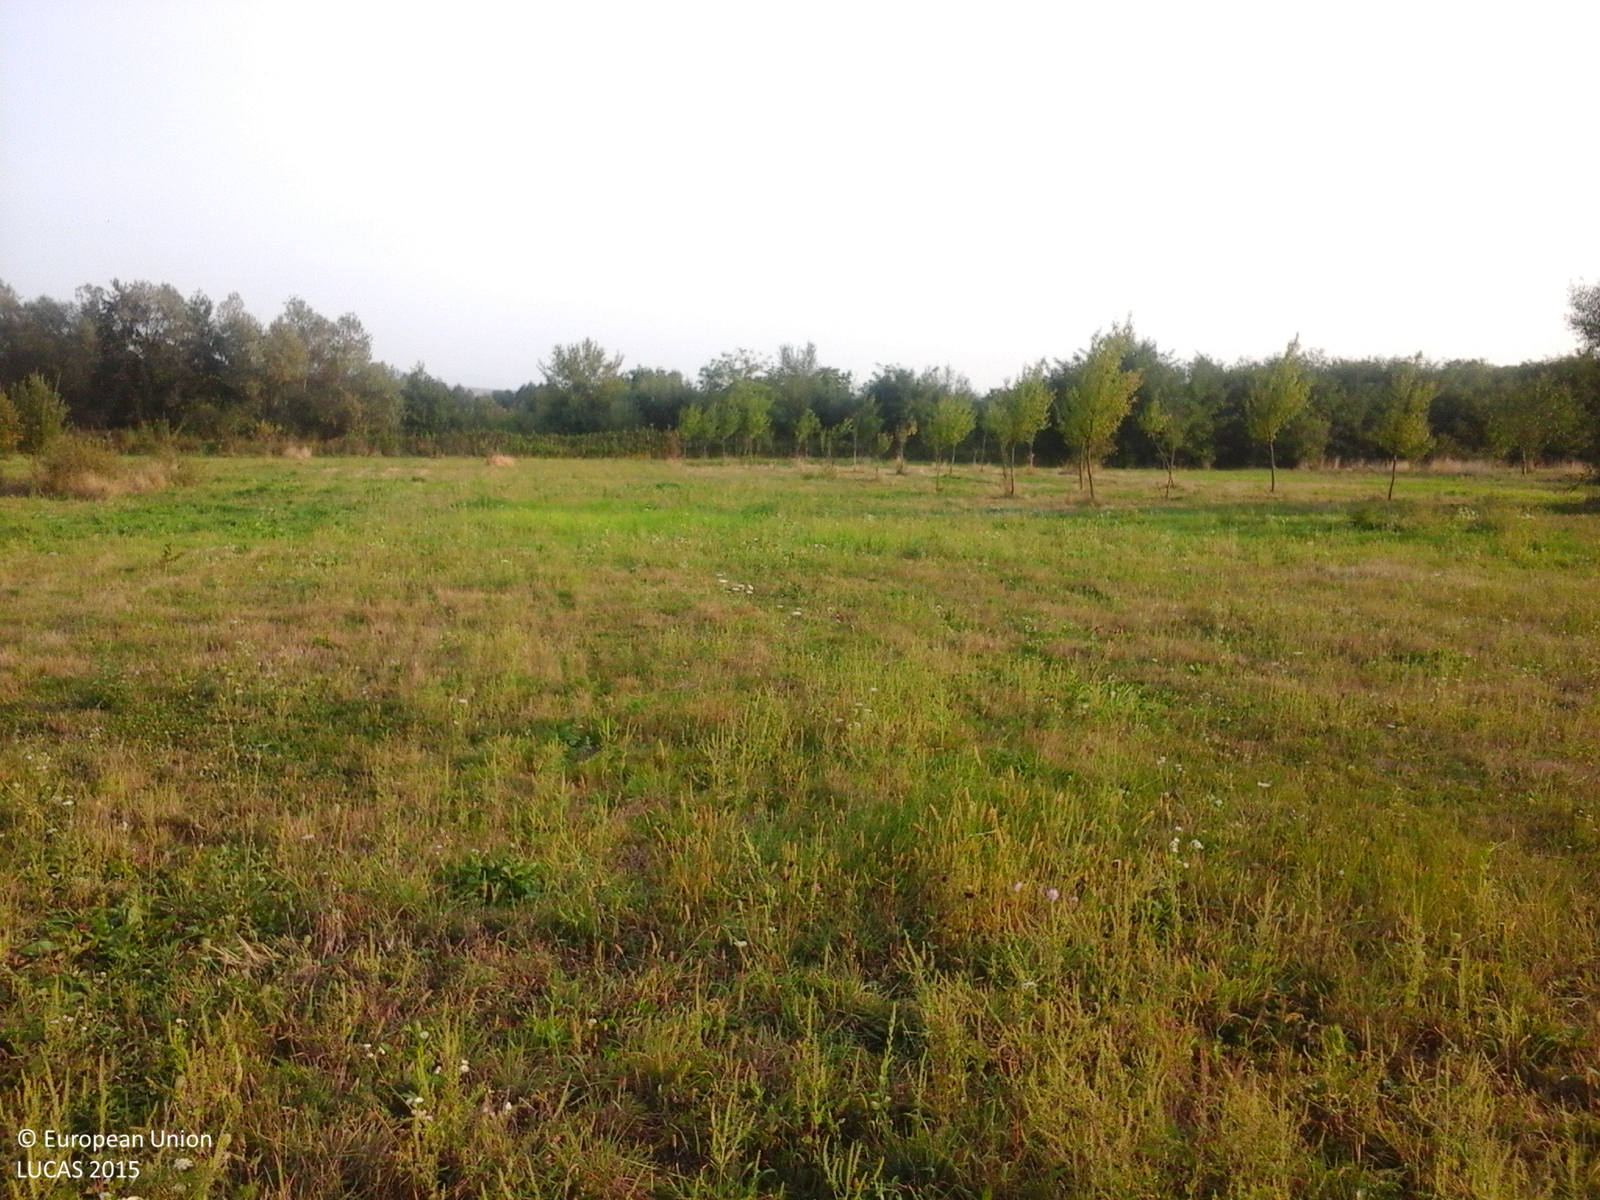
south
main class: Grassland
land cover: Grassland without tree/shrub cover
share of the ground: > 75 %
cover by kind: herbaceous plants 100 %
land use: Agriculture (excluding fallow land and kitchen gardens)
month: September
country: RO
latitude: 45.4939
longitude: 22.2884
